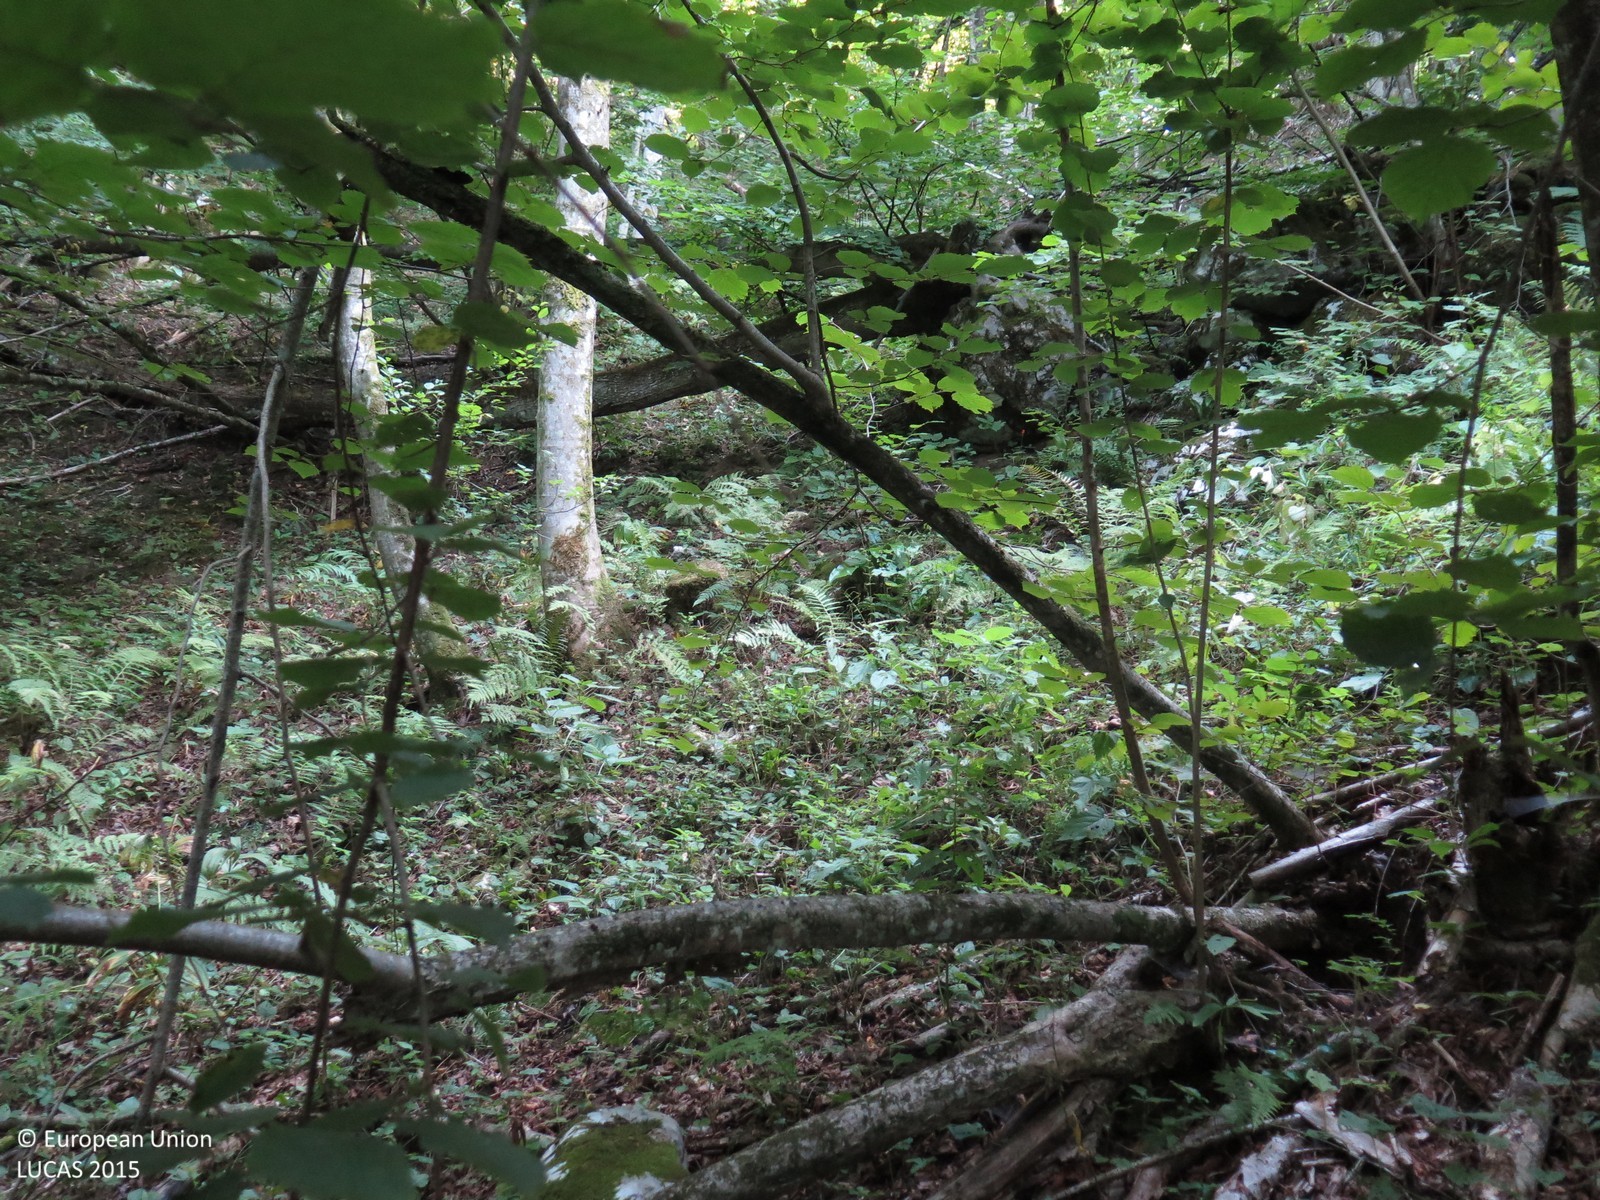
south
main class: Woodland
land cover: Broadleaved woodland
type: beech forest
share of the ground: > 75 %
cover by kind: broadleaved forest trees 95 %, herbaceous plants 5 %
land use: Forestry
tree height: > 5 m
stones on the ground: < 10 %
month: August
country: HR
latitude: 45.3612
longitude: 15.1402
